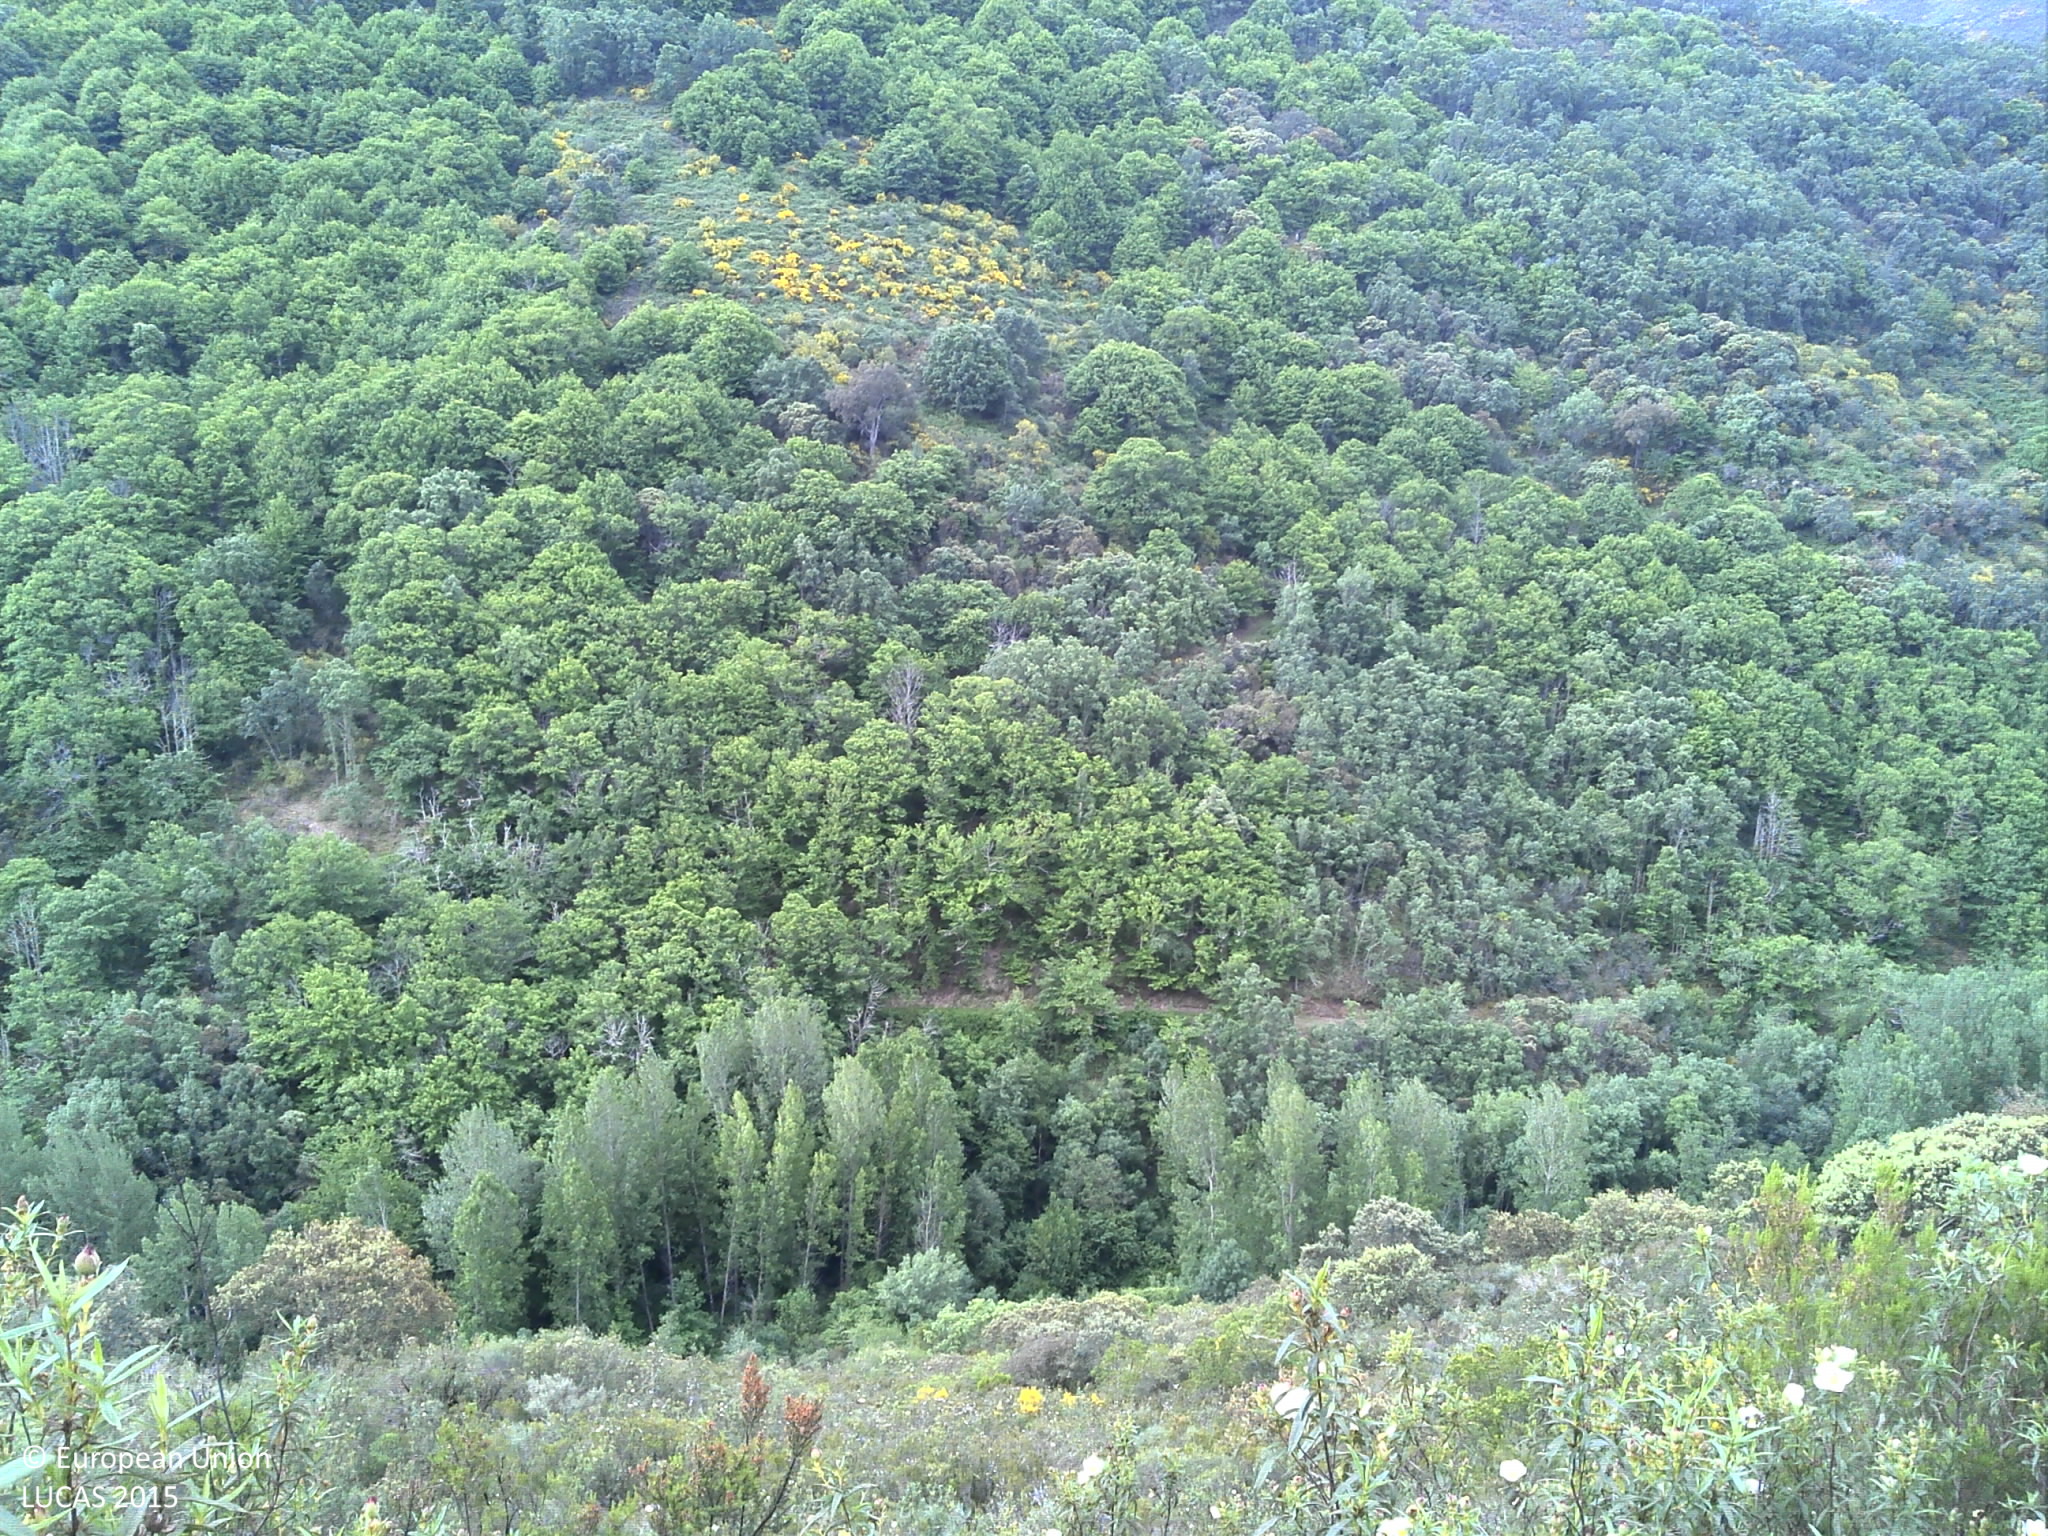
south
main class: Shrubland
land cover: Shrubland without tree cover
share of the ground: > 75 %
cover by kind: shrubs 90 %, unconsolidated bare surface 10 %
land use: Abandoned areas
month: May
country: PT
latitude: 41.7934
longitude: -7.0026
